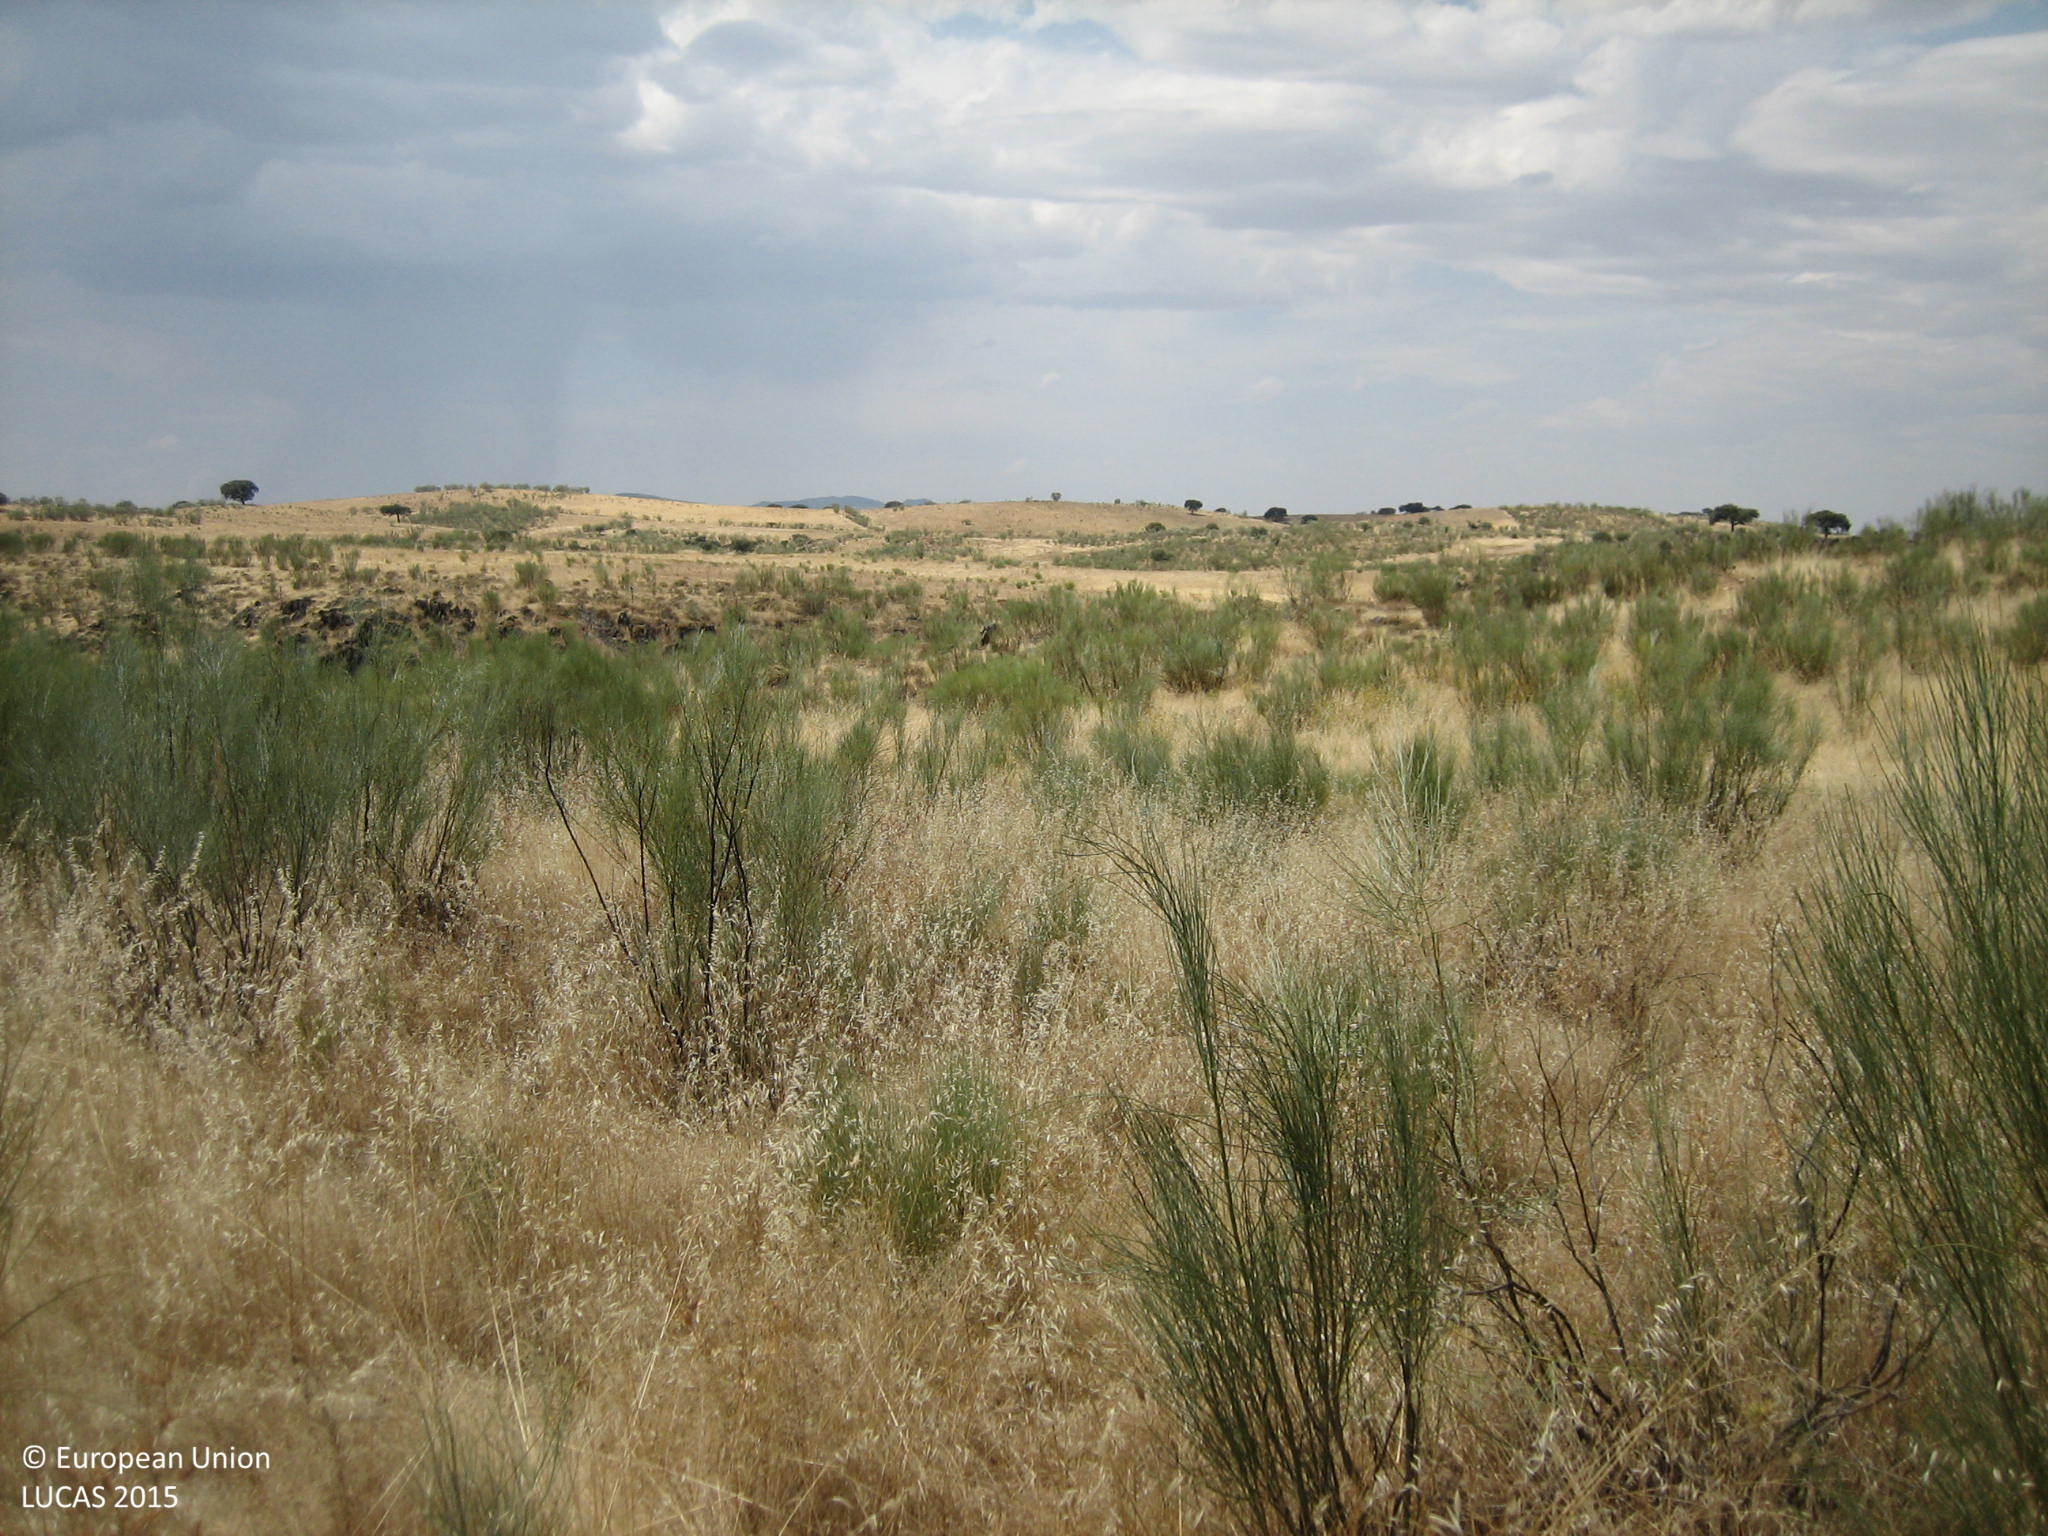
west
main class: Shrubland
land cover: Shrubland without tree cover
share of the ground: 25 - 50 %
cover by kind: herbaceous plants 70 %, shrubs 30 %
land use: Agriculture (excluding fallow land and kitchen gardens)
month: July
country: ES
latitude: 38.5366
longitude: -5.3490
